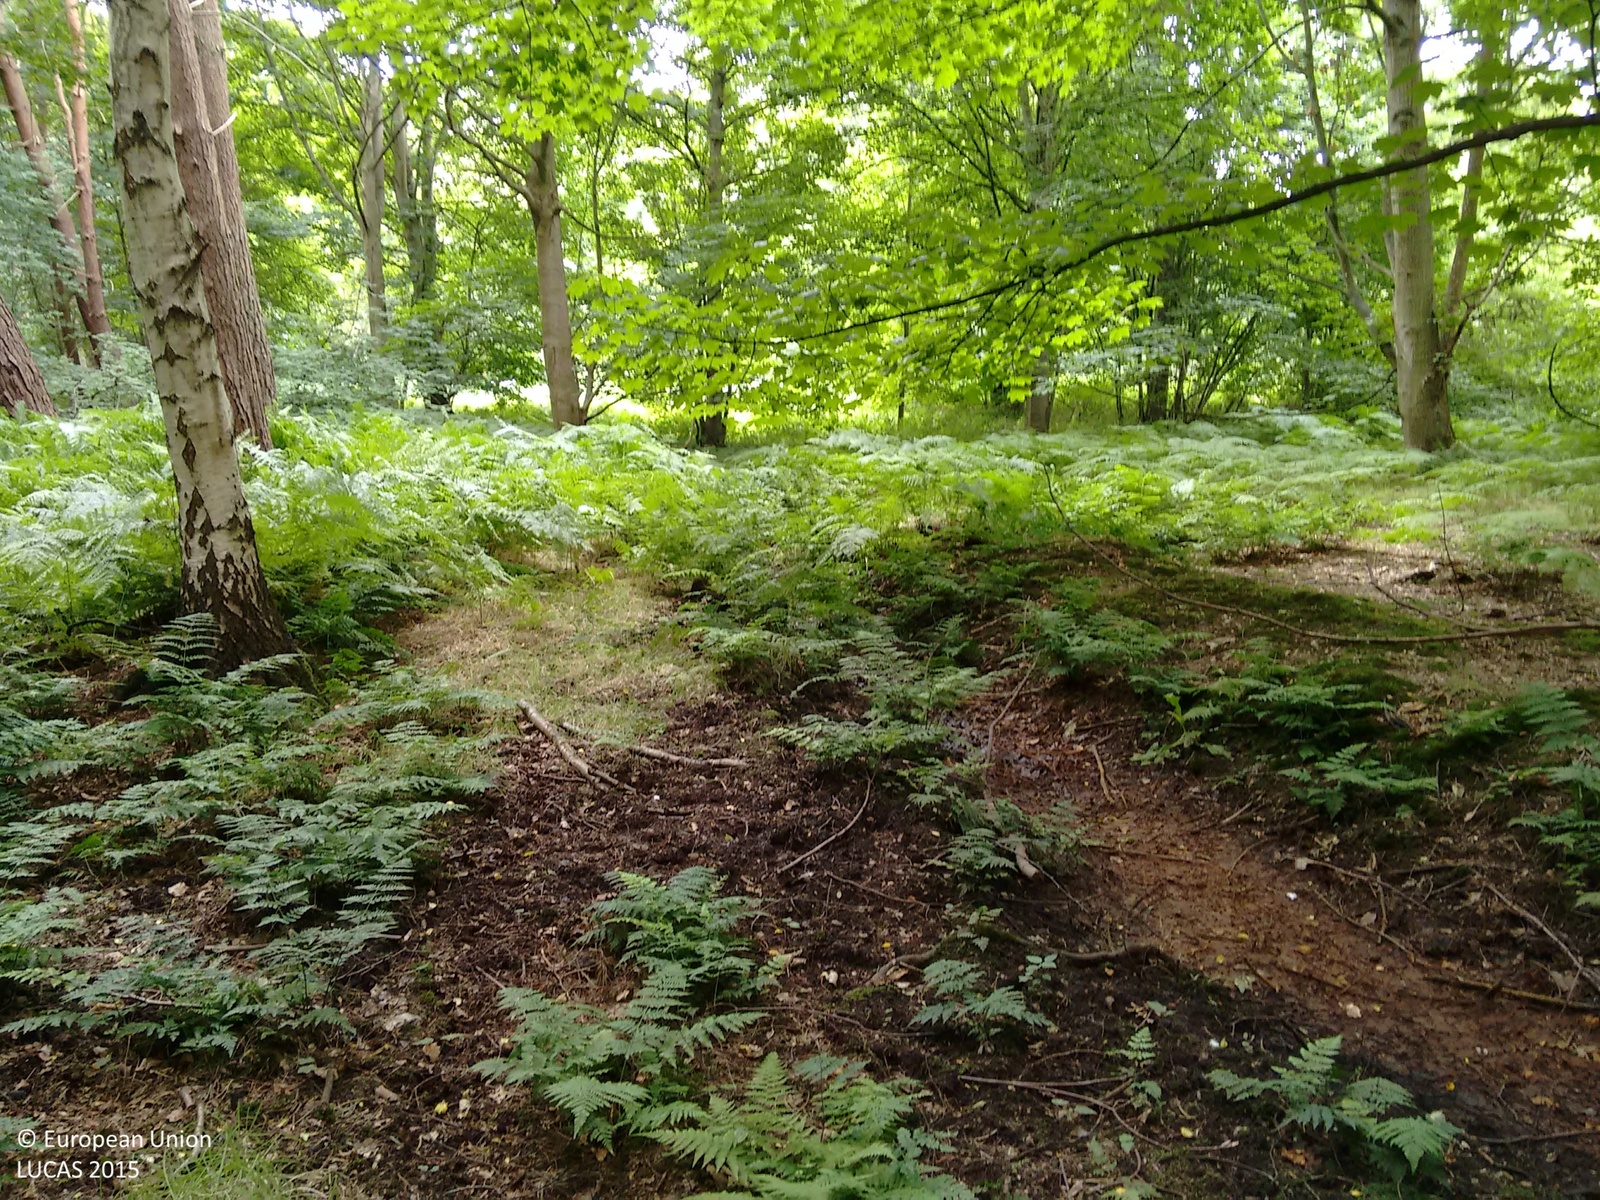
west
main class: Woodland
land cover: Broadleaved woodland
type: mesophytic deciduous forest
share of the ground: > 75 %
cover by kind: broadleaved forest trees 100 %
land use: Forestry
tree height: > 5 m
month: August
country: GB
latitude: 52.6403
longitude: 0.4104
